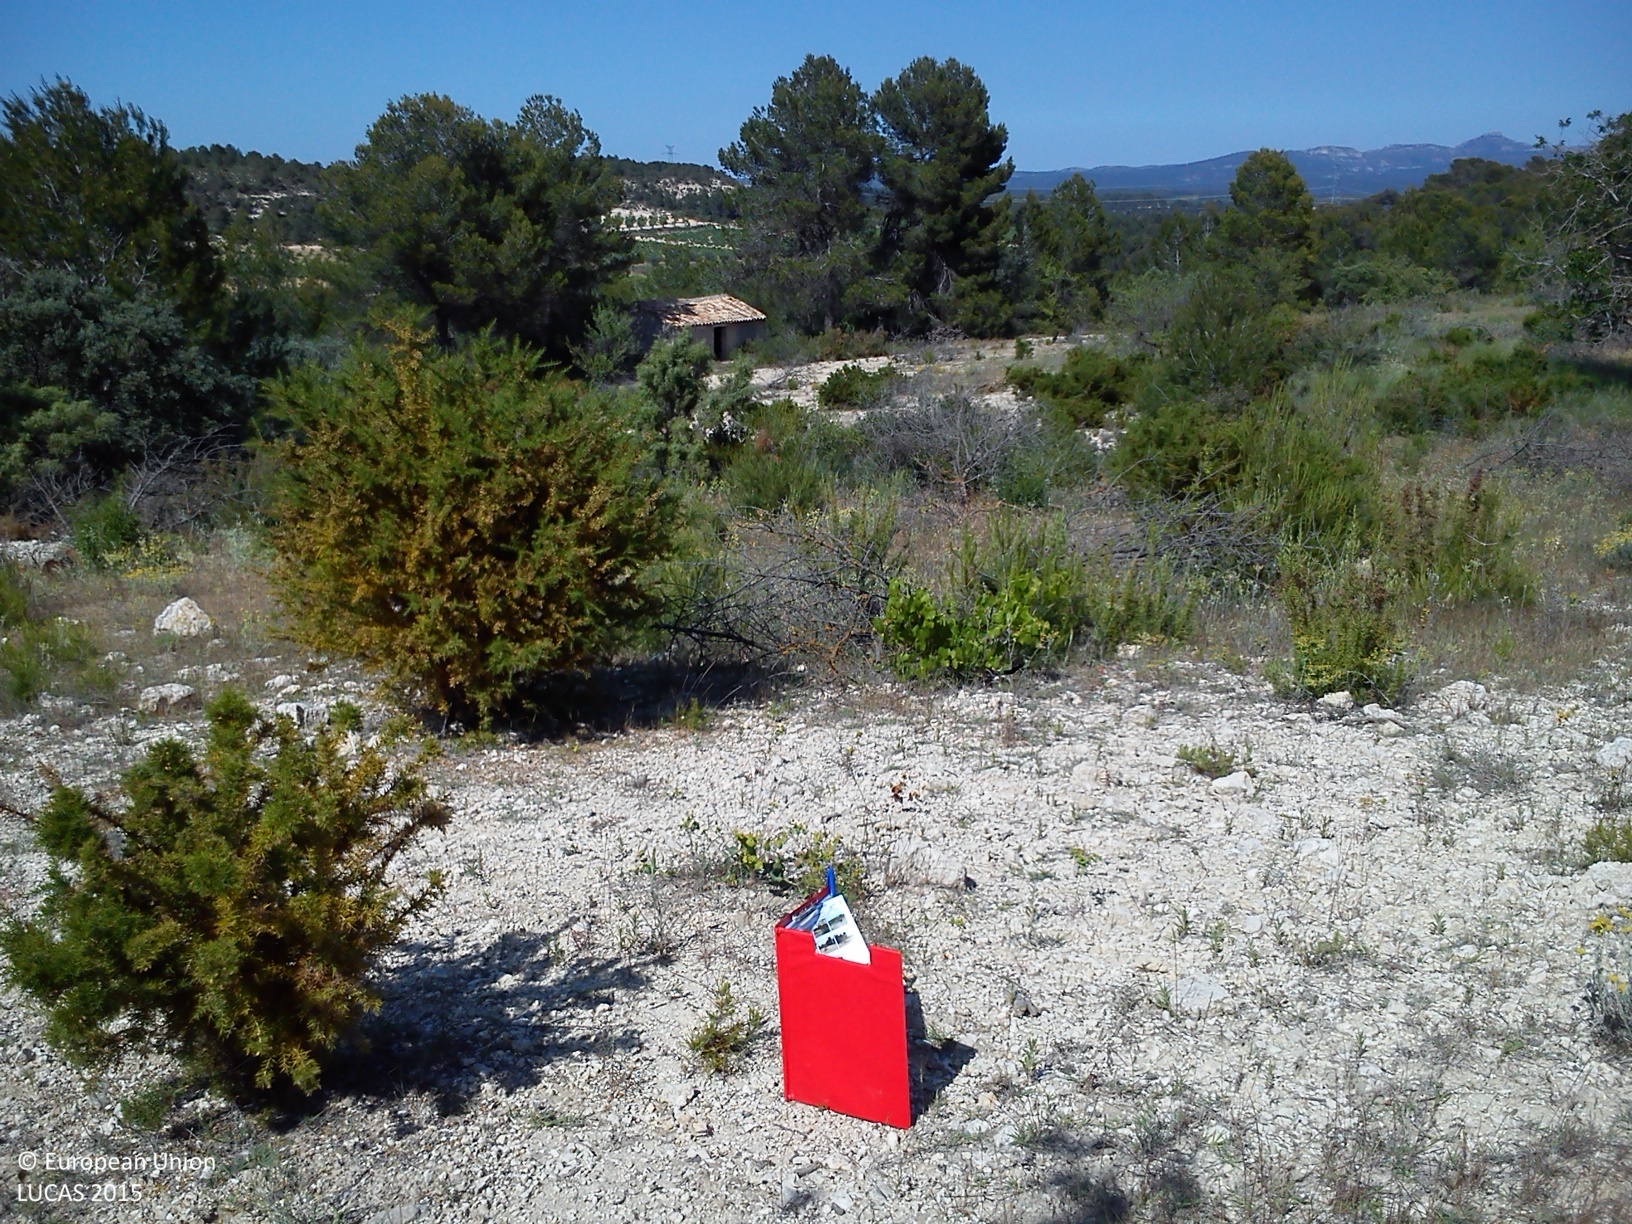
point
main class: Shrubland
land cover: Shrubland with sparse tree cover
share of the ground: 10 - 25 %
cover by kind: herbaceous plants 40 %, unconsolidated bare surface 35 %, shrubs 20 %, coniferous forest trees 5 %
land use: Abandoned areas
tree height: < 5 m
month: June
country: ES
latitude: 39.3098
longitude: -1.0746
